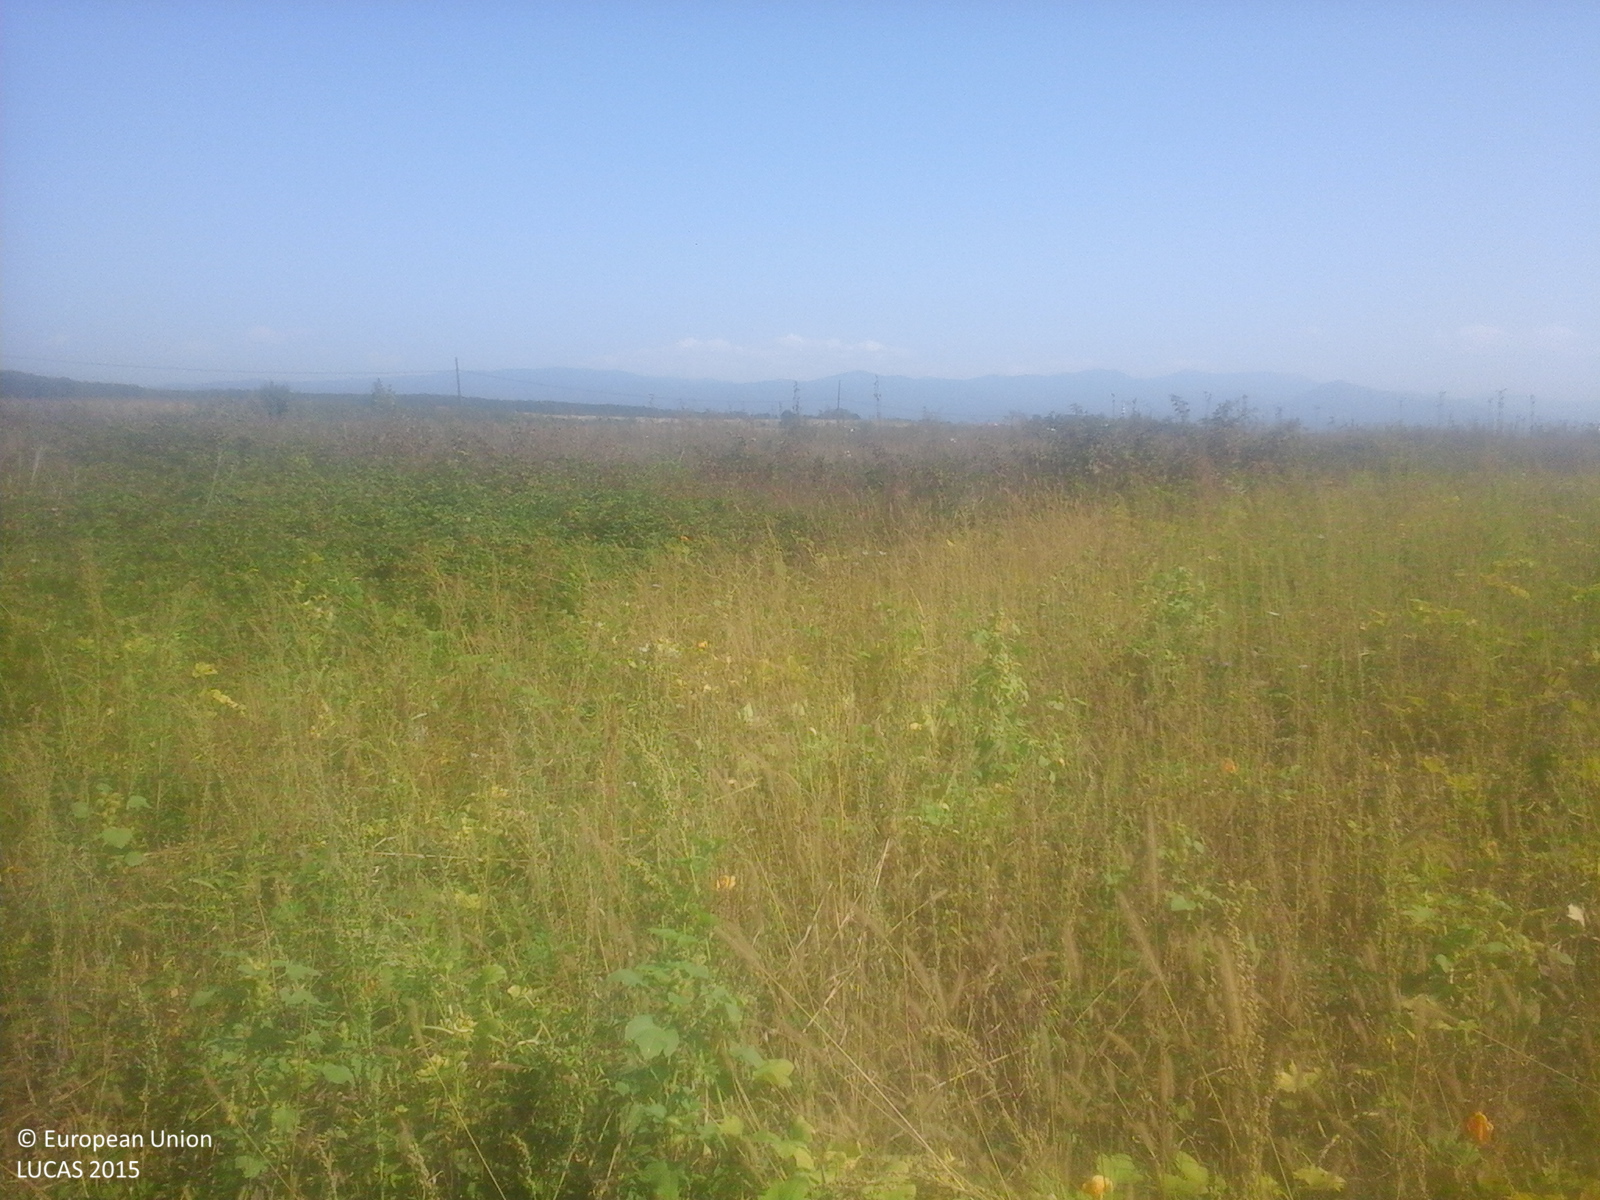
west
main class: Cropland
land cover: Maize
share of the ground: > 75 %
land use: Agriculture (excluding fallow land and kitchen gardens)
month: September
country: RO
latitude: 46.6733
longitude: 22.3243
